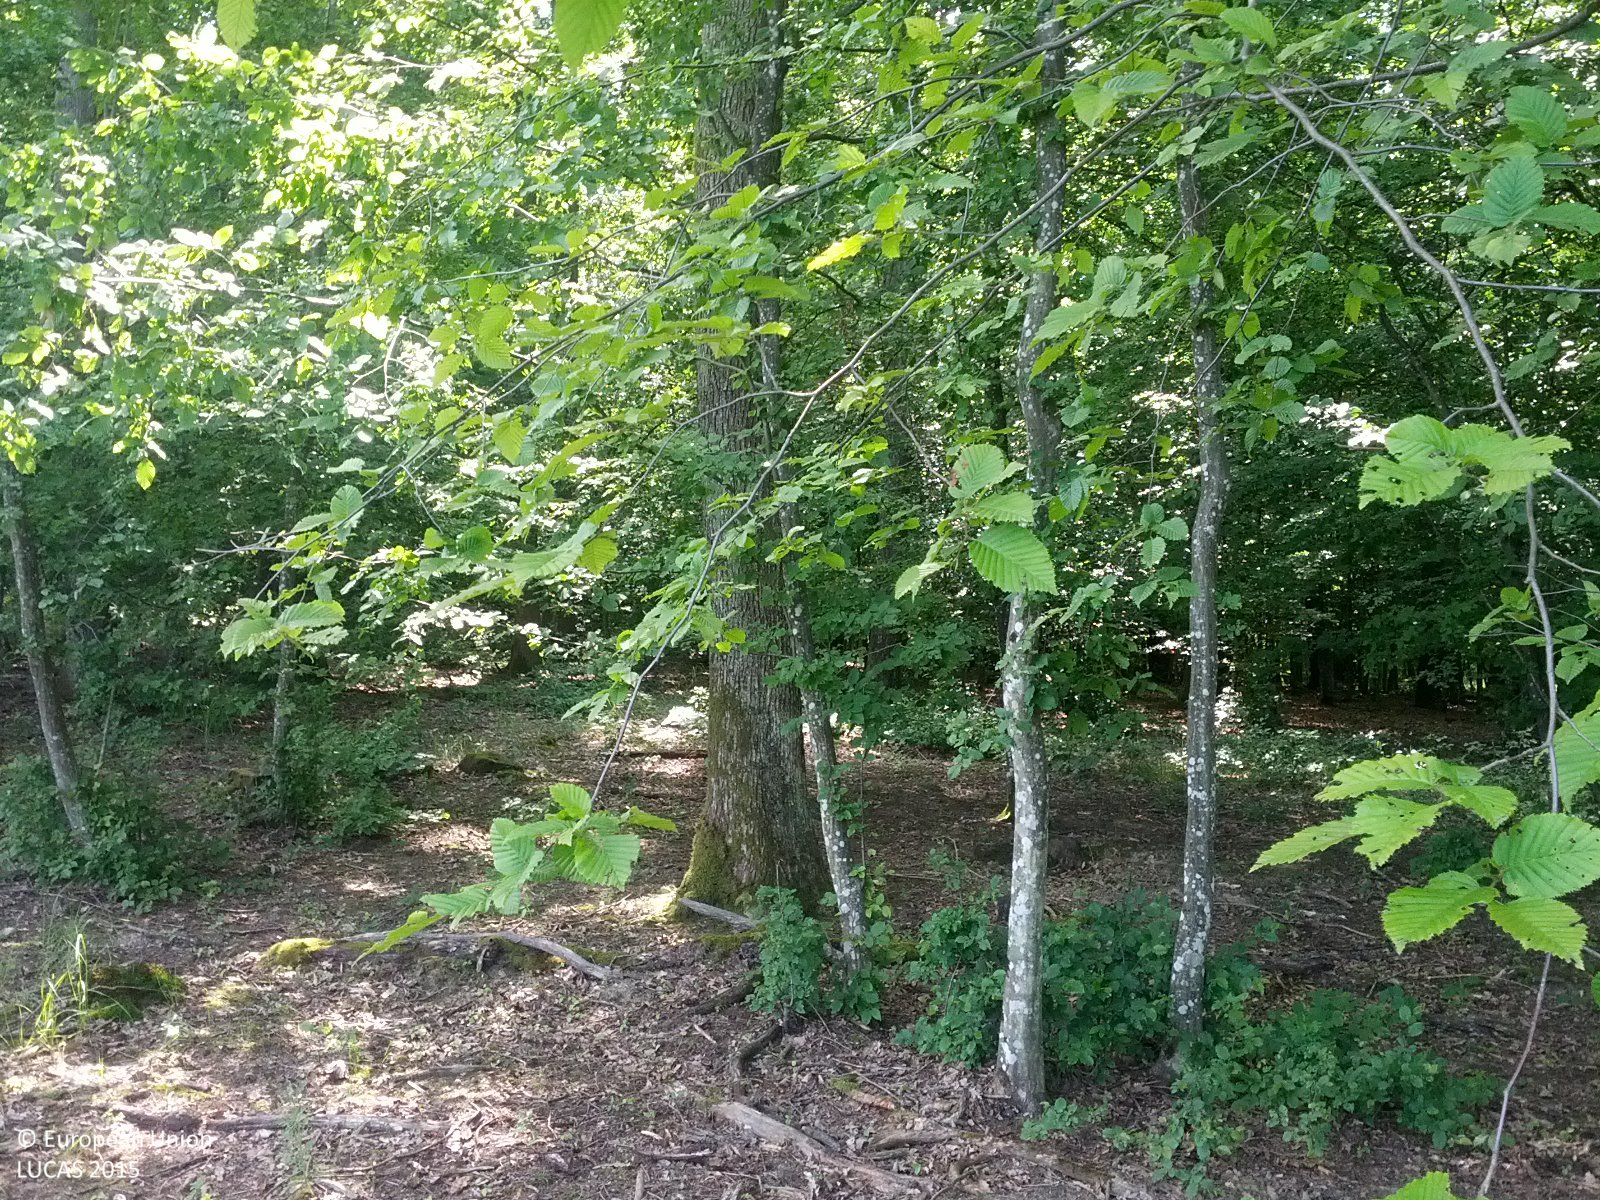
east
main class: Woodland
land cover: Broadleaved woodland
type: beech forest
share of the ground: 50 - 75 %
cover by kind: broadleaved forest trees 60 %, unconsolidated bare surface 20 %, herbaceous plants 15 %, shrubs 5 %
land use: Forestry
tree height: > 5 m
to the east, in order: Broadleaved woodland; Grass margins; Tracks; Shrubland with sparse tree cover; Other mixed woodland; Spontaneously vegetated surfaces
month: June
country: AT
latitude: 47.0992
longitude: 16.3925
